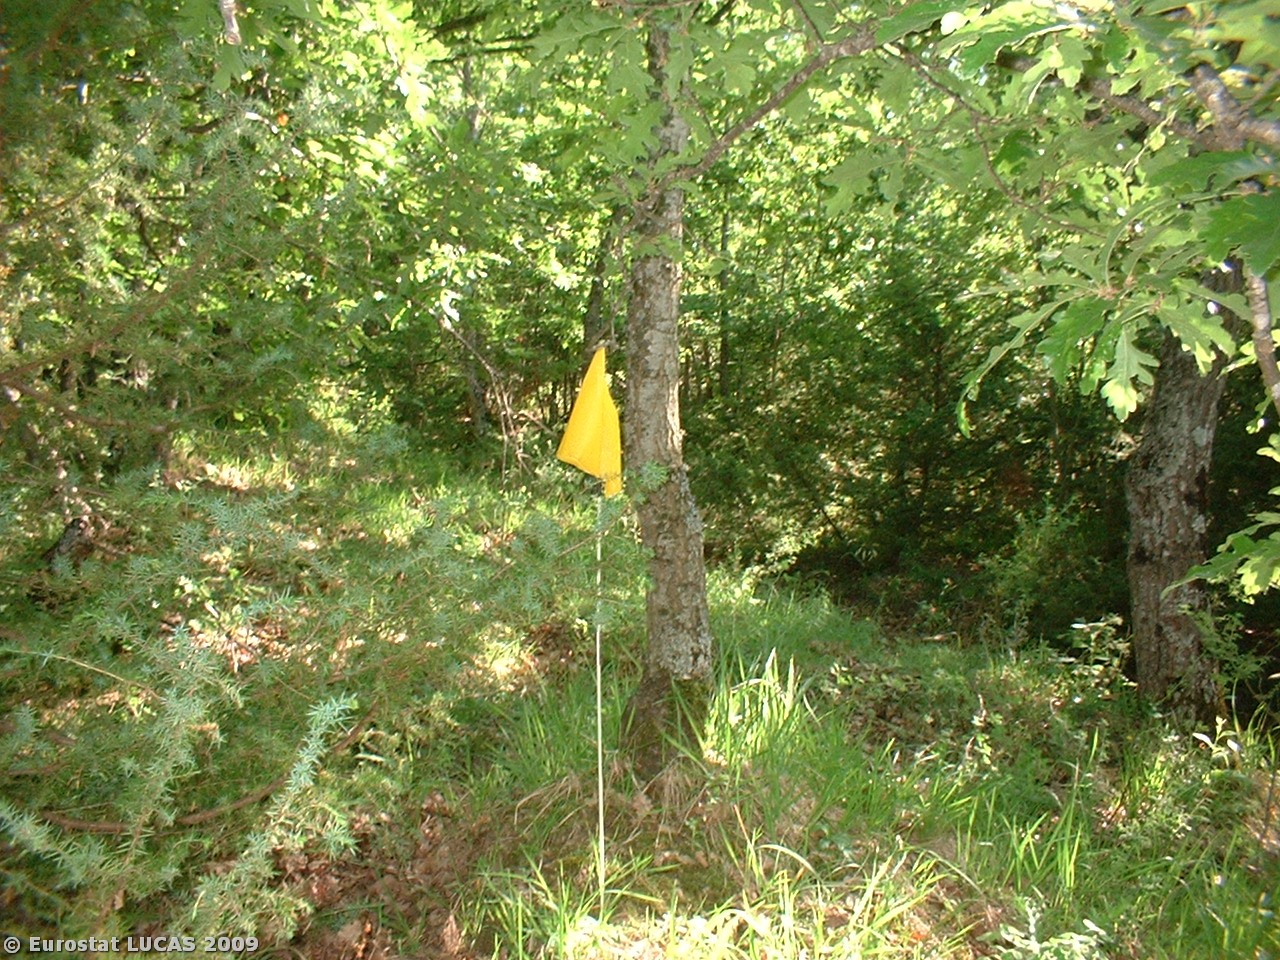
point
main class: Woodland
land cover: Broadleaved woodland
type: mesophytic deciduous forest
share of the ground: > 75 %
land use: Forestry
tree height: > 5 m
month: June
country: IT
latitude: 42.7284
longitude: 13.2512
